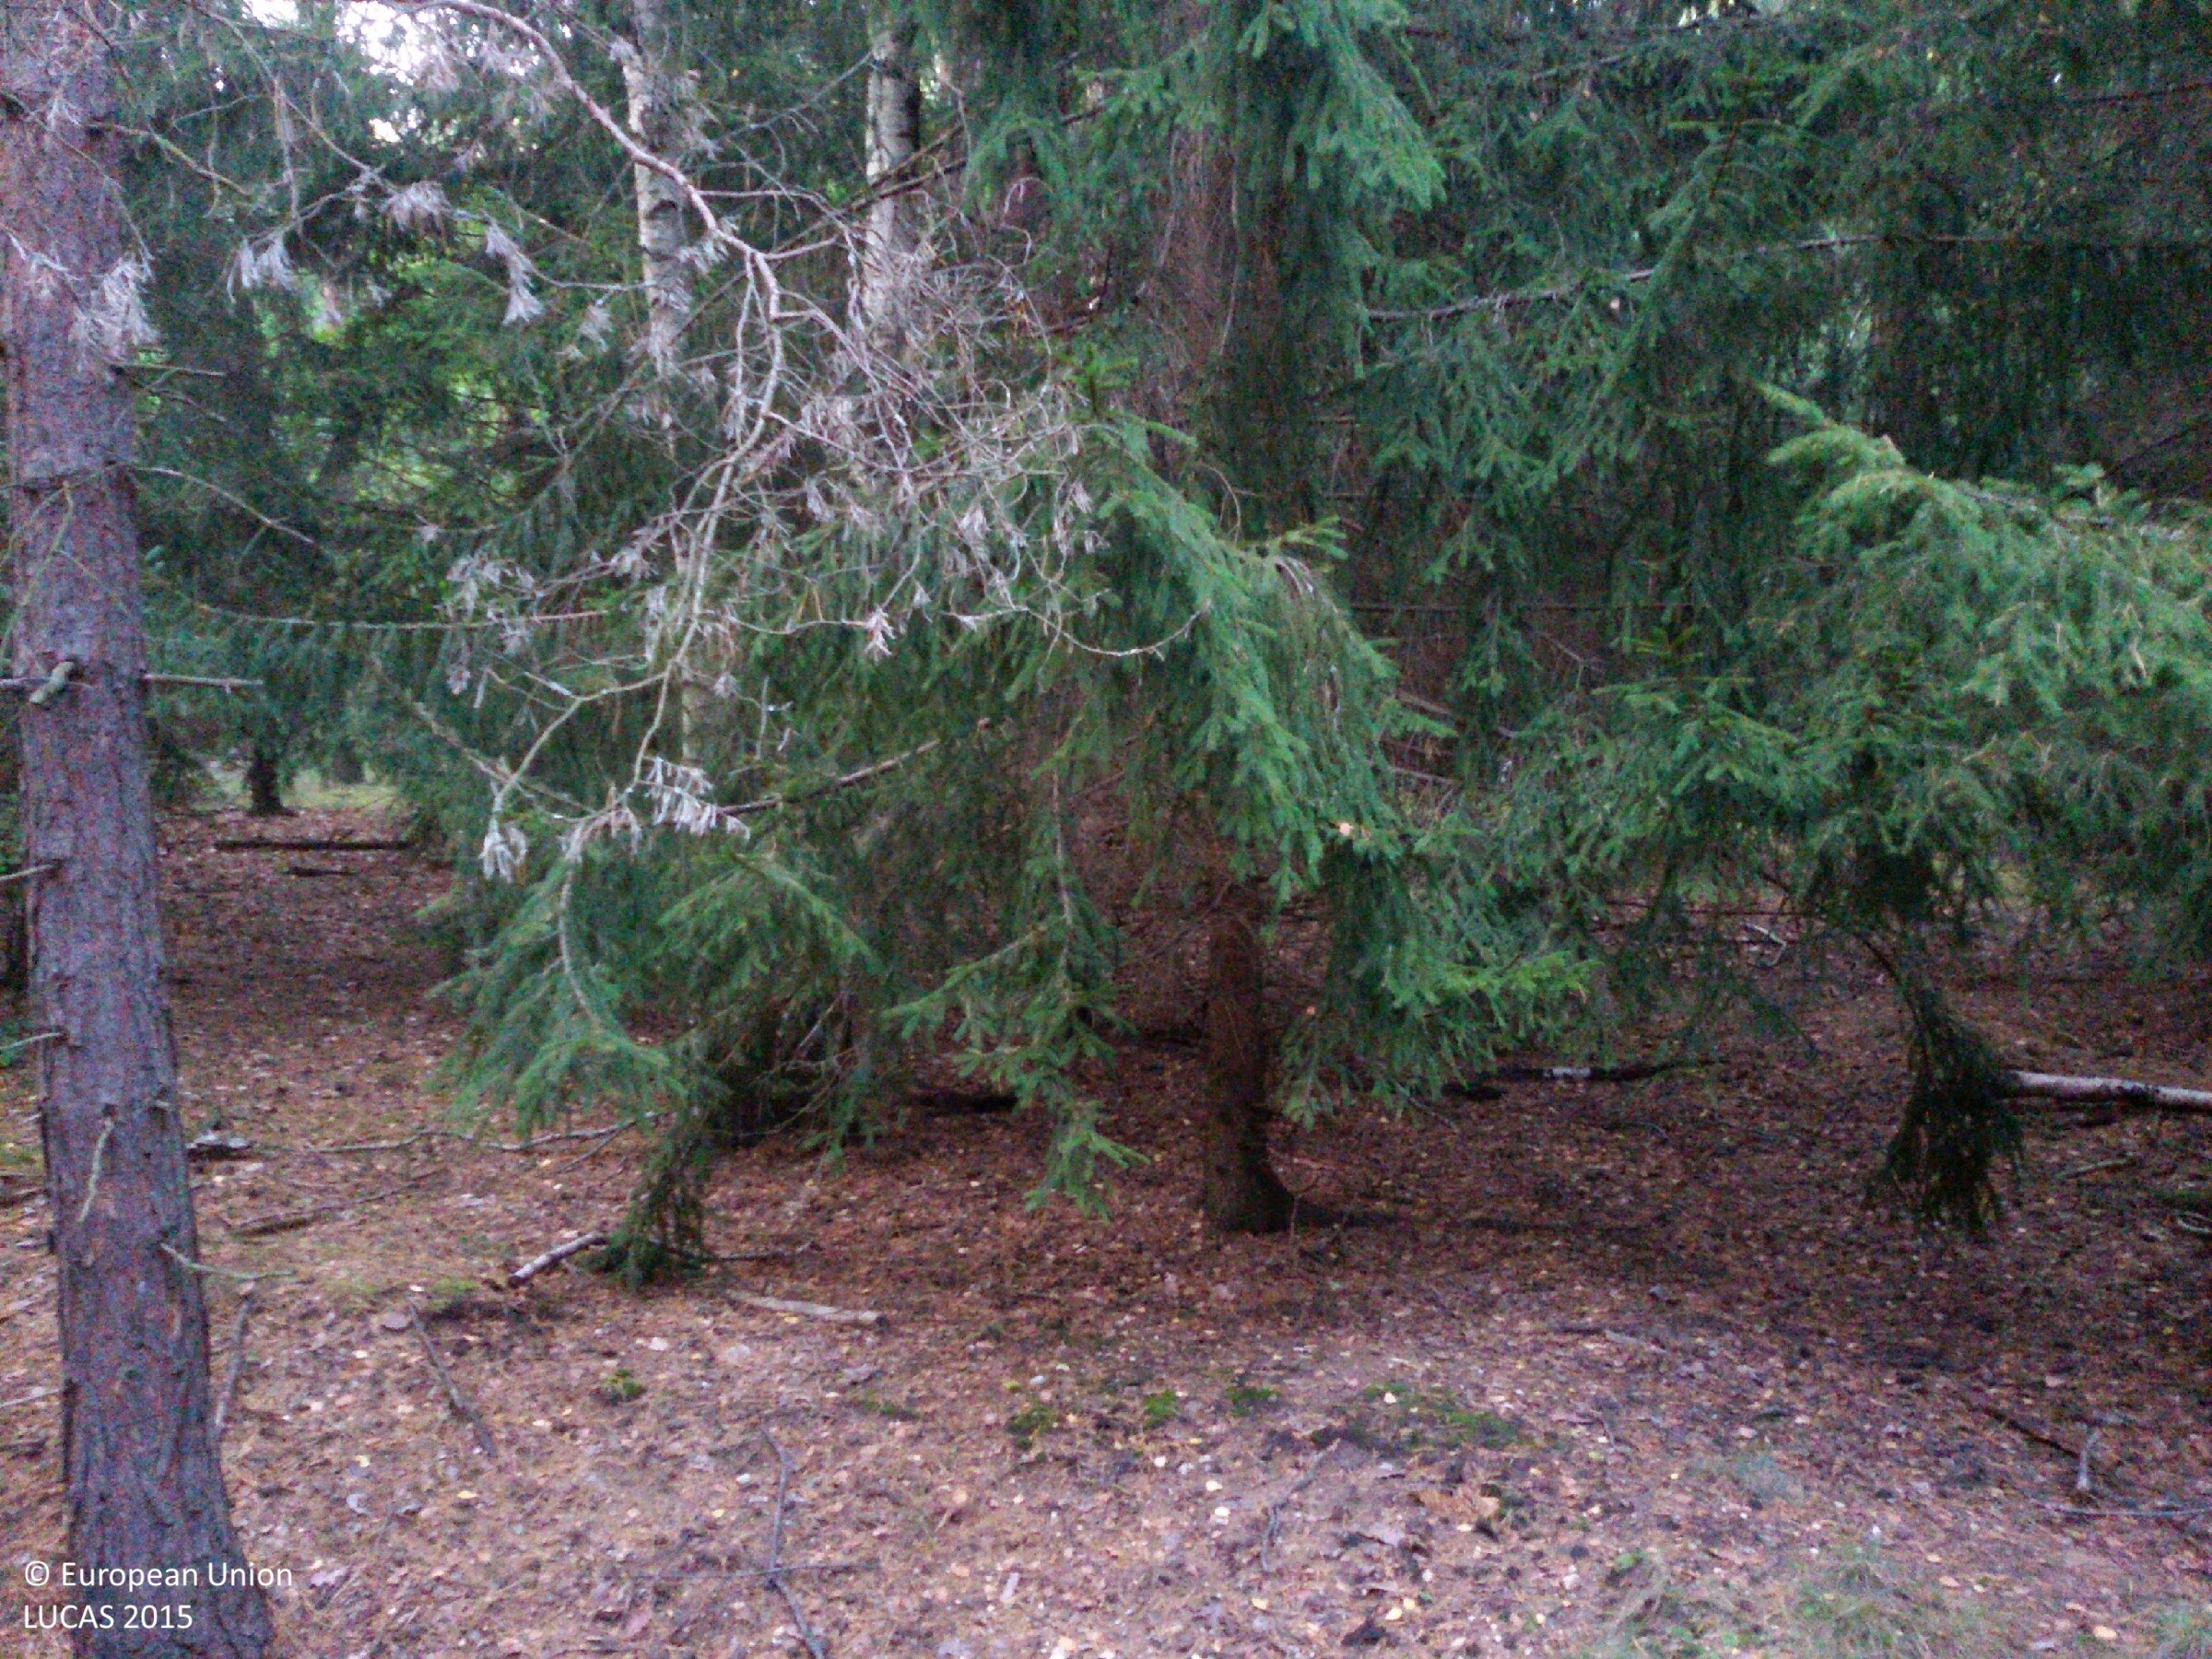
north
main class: Woodland
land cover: Pine dominated mixed woodland
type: hemiboreal forest and nemoral coniferous forest and mixed broadleaved-coniferous forest
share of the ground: > 75 %
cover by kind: coniferous forest trees 55 %, broadleaved forest trees 25 %, shrubs 10 %, herbaceous plants 5 %, lichens and mosses 5 %
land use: Forestry
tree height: > 5 m
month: September
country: PL
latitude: 51.5634
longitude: 14.7194
